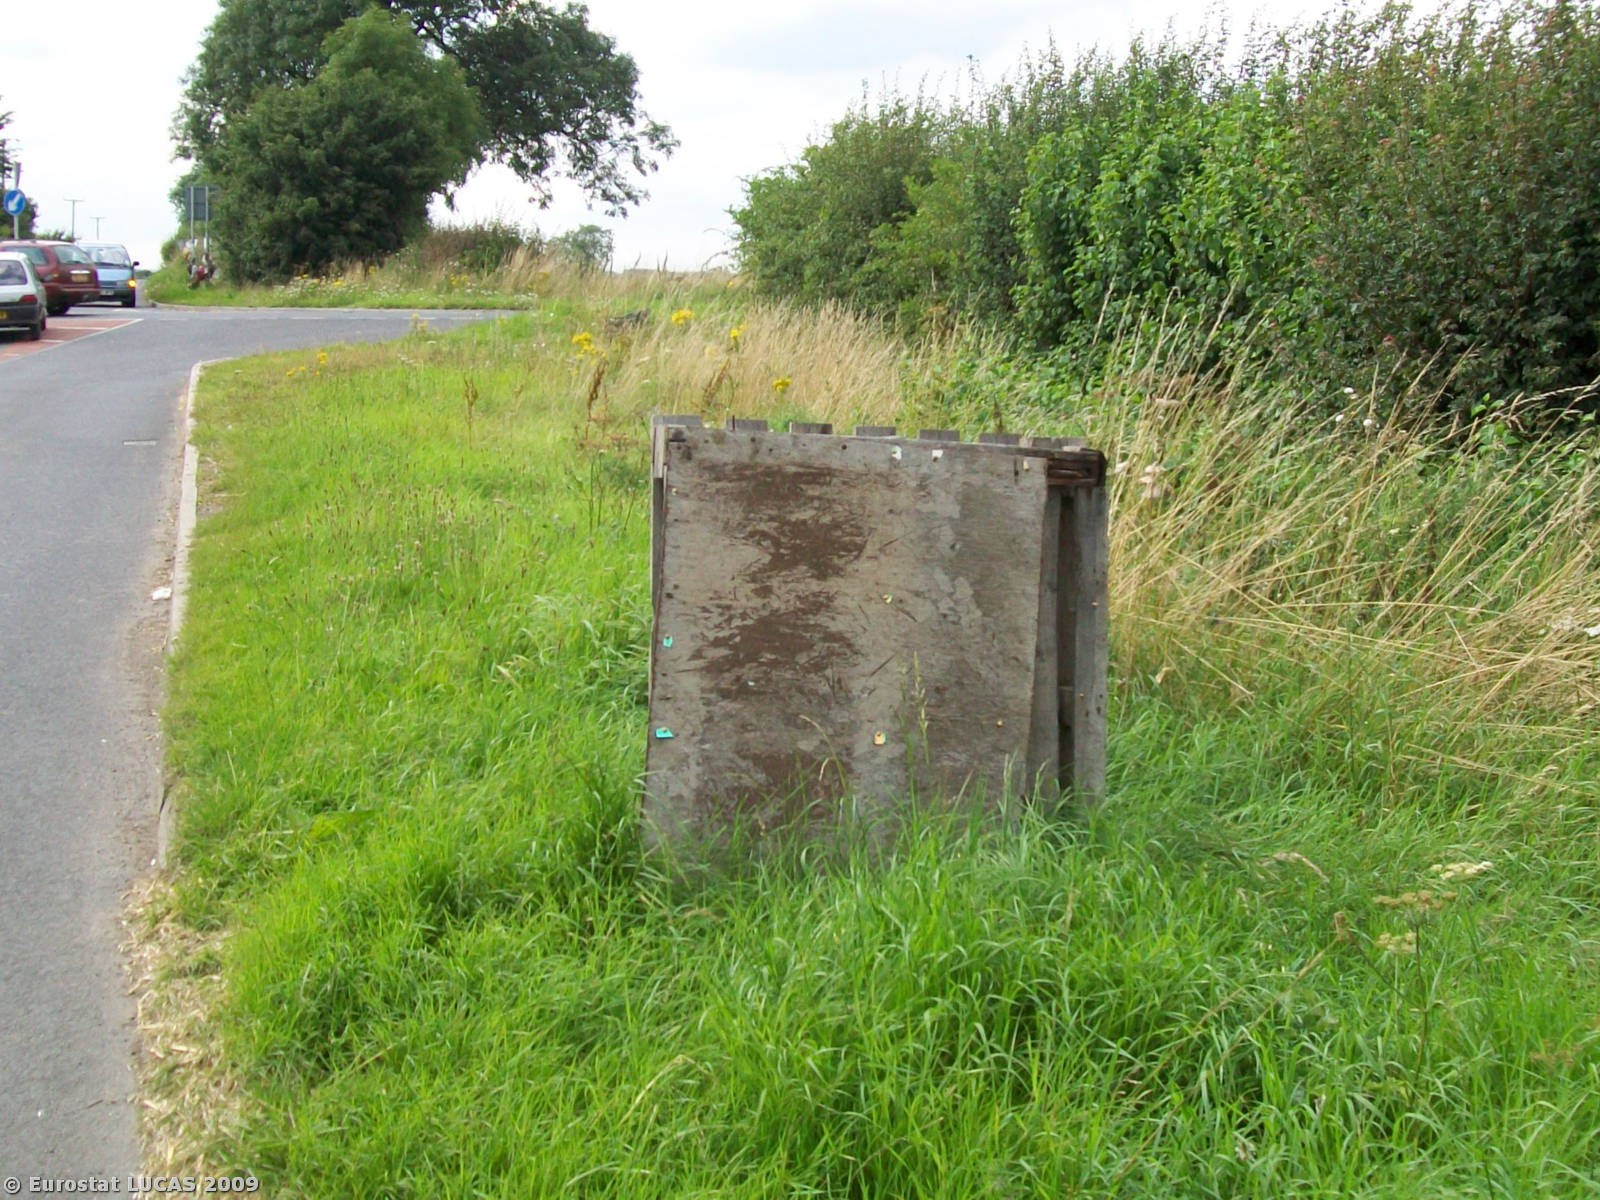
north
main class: Grassland
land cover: Grassland without tree/shrub cover
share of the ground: > 75 %
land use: Unused
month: August
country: GB
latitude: 53.3668
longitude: -1.2428
